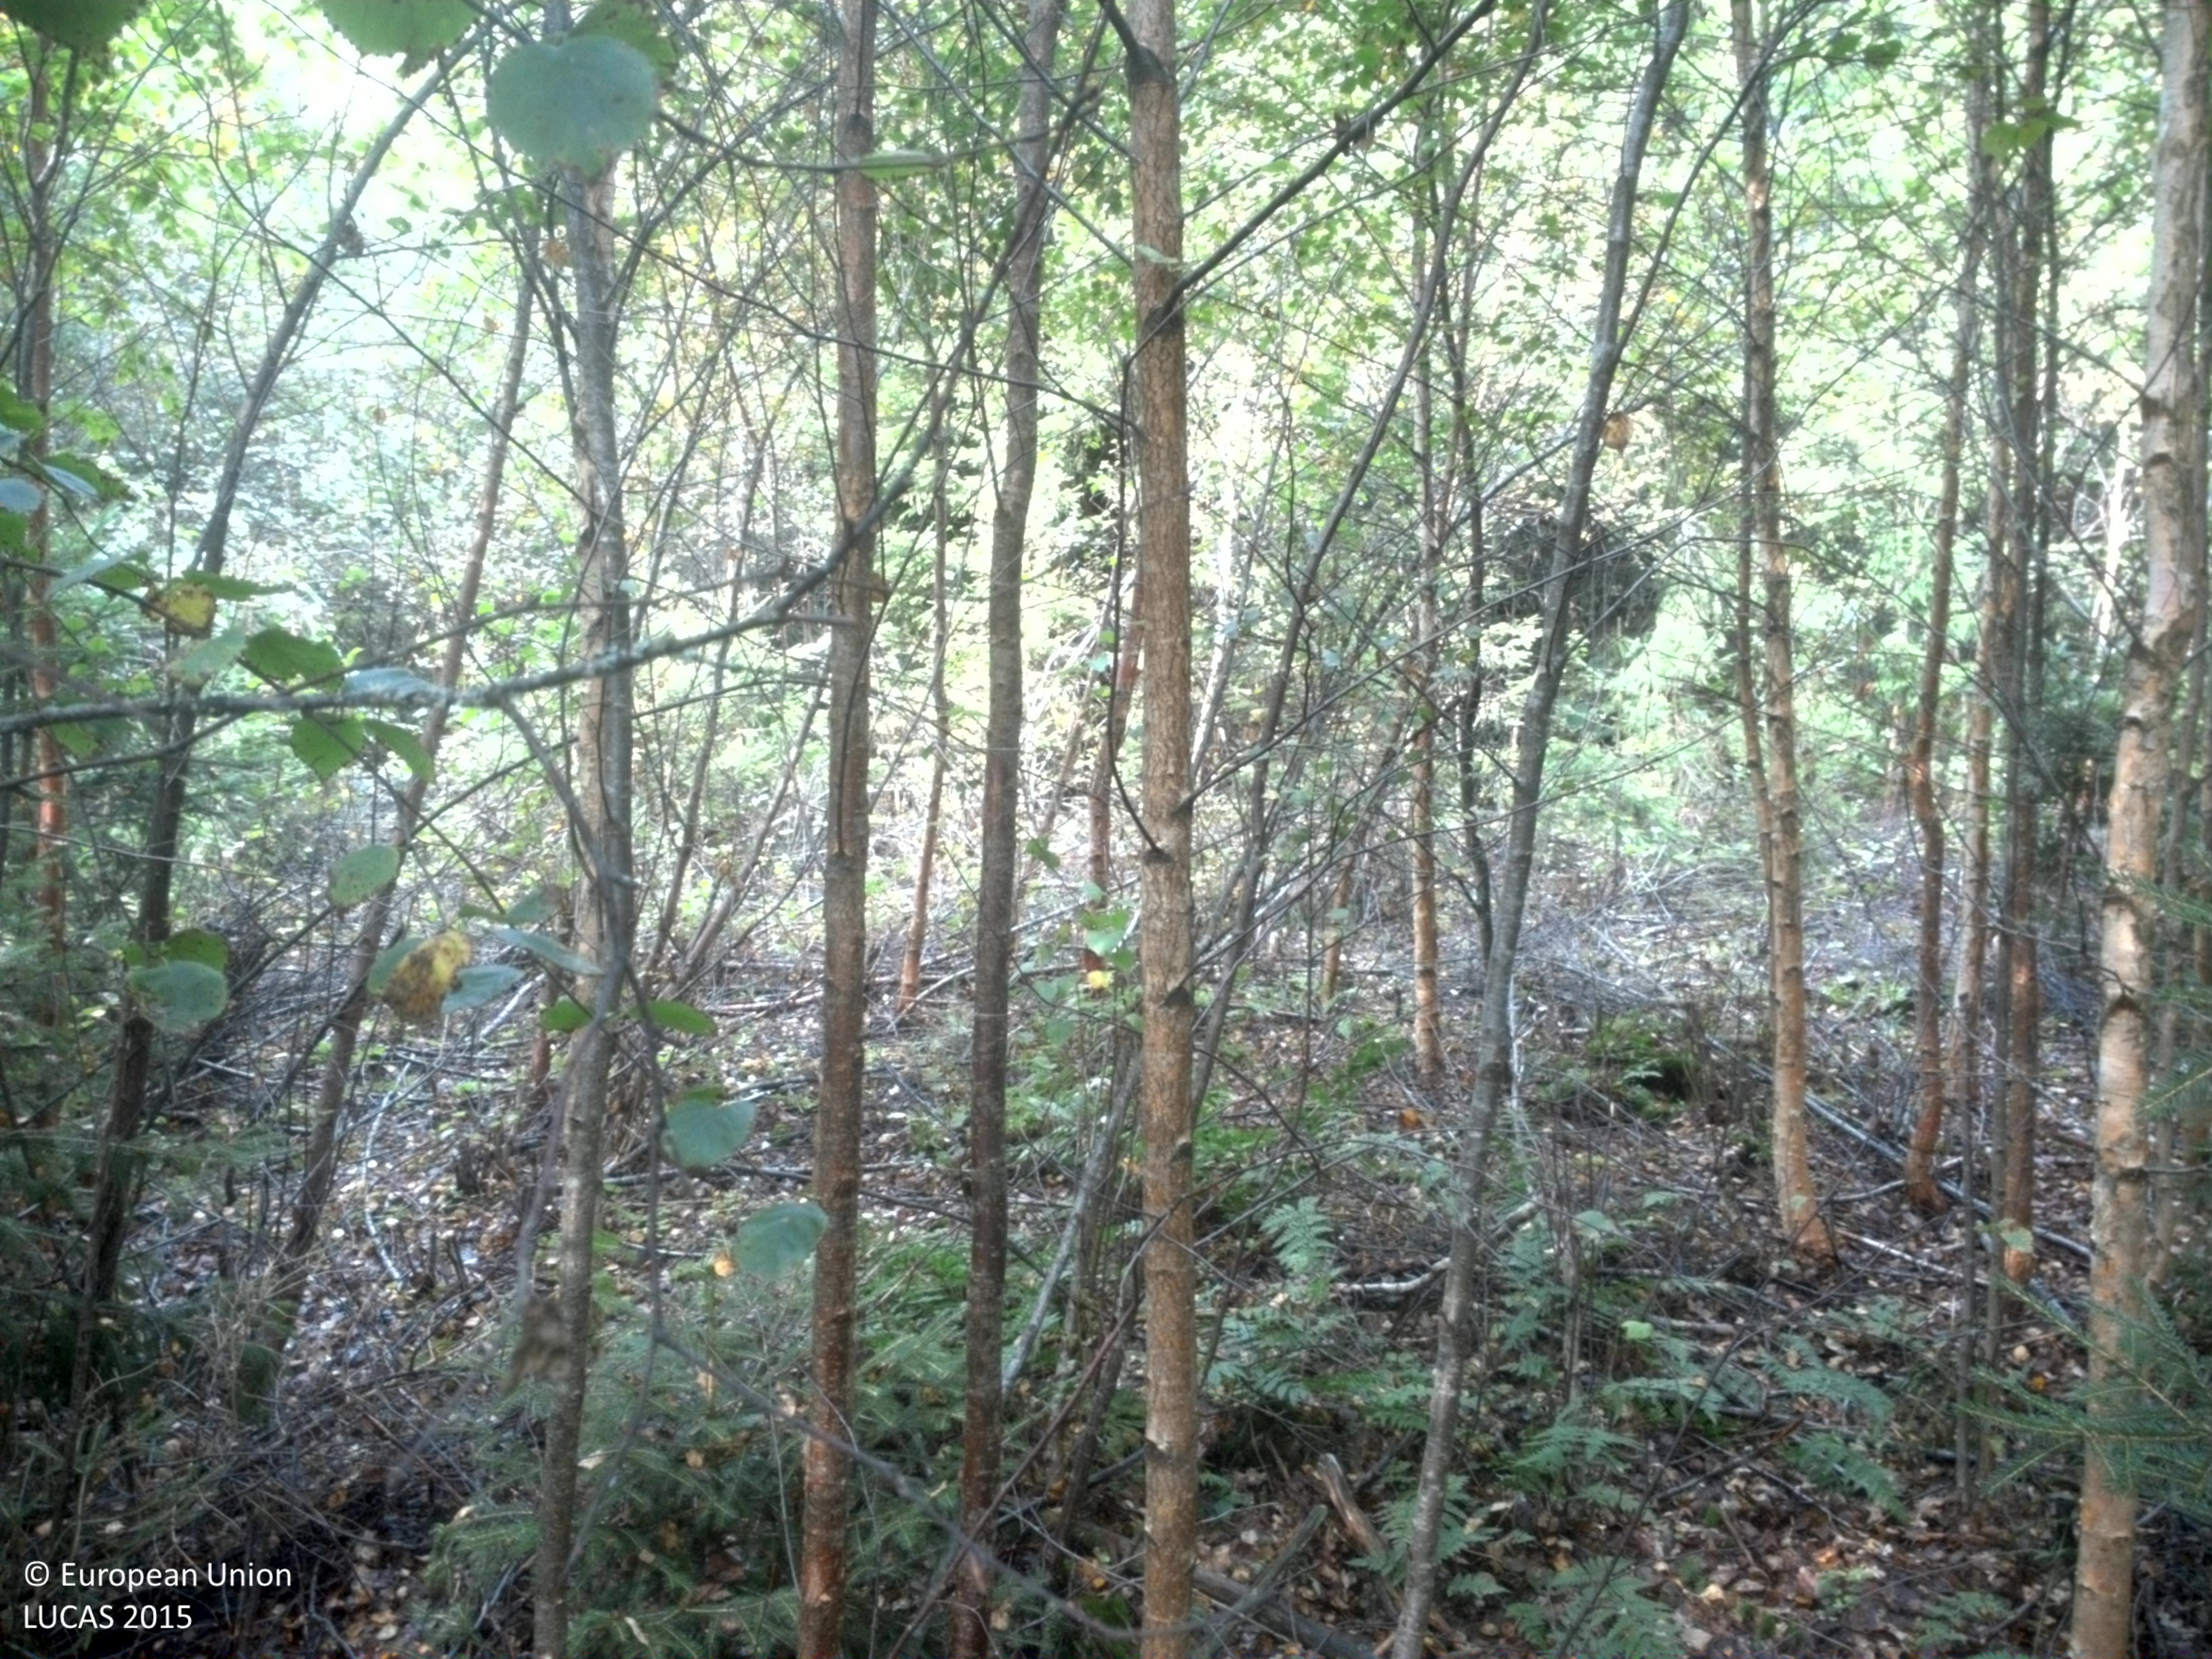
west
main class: Woodland
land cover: Spruce dominated mixed woodland
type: boreal forest
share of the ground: > 75 %
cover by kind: broadleaved forest trees 50 %, coniferous forest trees 25 %, unconsolidated bare surface 10 %, shrubs 5 %, herbaceous plants 5 %
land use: Forestry
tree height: > 5 m
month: September
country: SE
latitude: 59.5569
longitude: 15.7771
